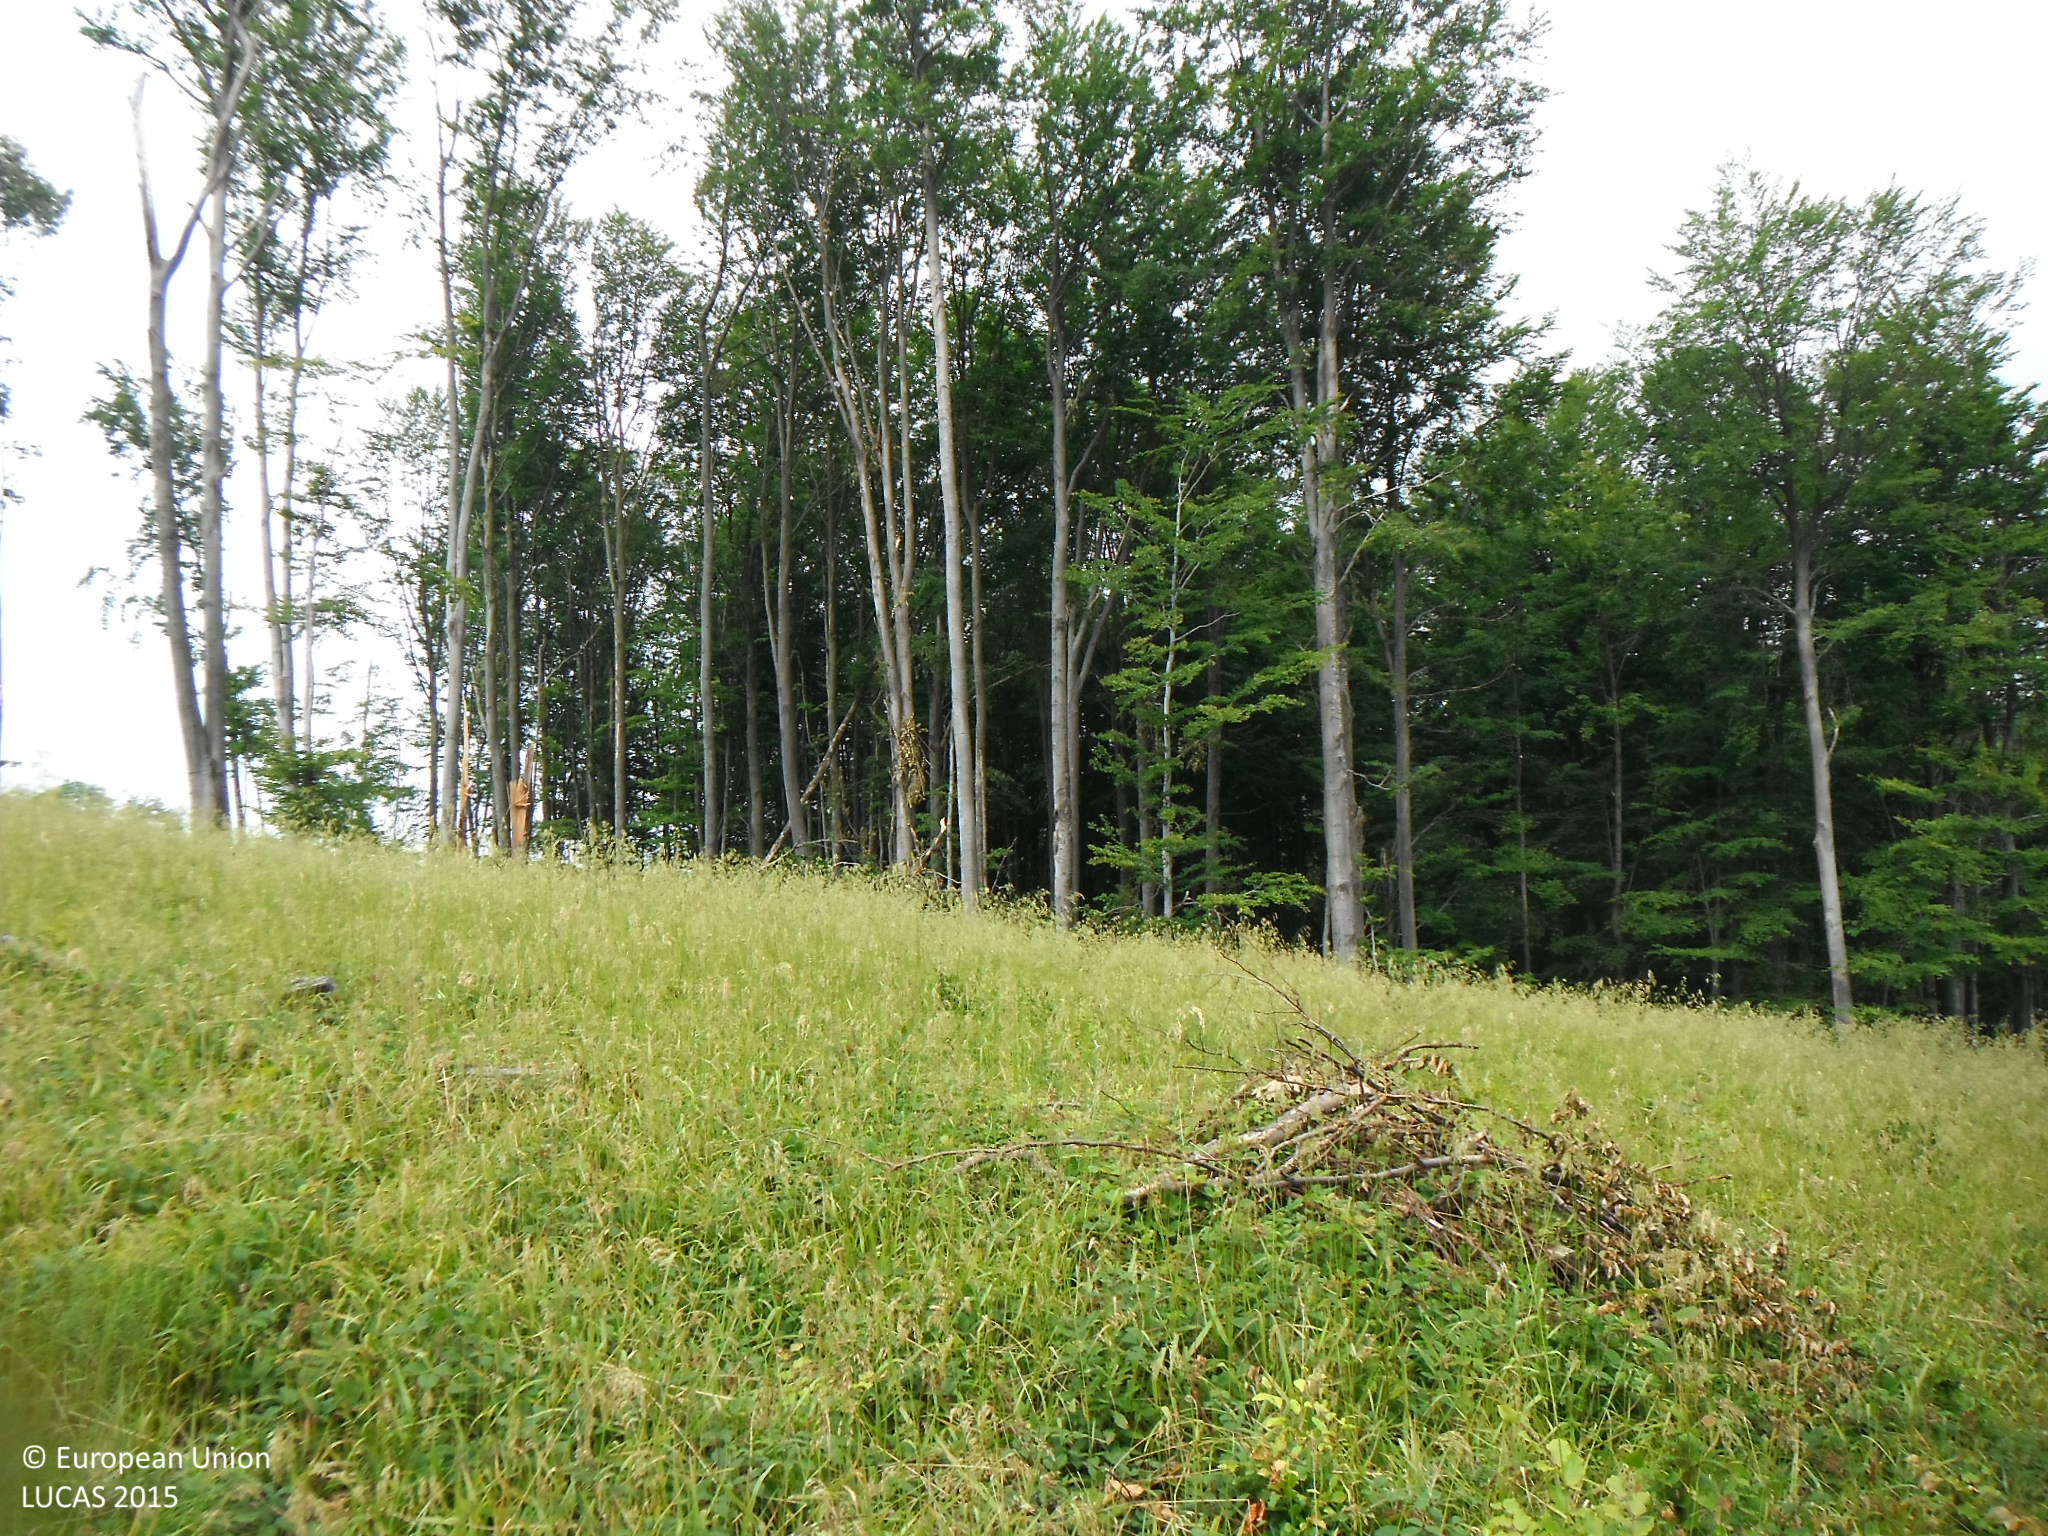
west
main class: Grassland
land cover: Spontaneously vegetated surfaces
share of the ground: > 75 %
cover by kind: herbaceous plants 95 %, shrubs 5 %
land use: Forestry
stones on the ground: 25 - 50 %
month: July
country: SK
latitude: 49.3162
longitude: 21.9548
